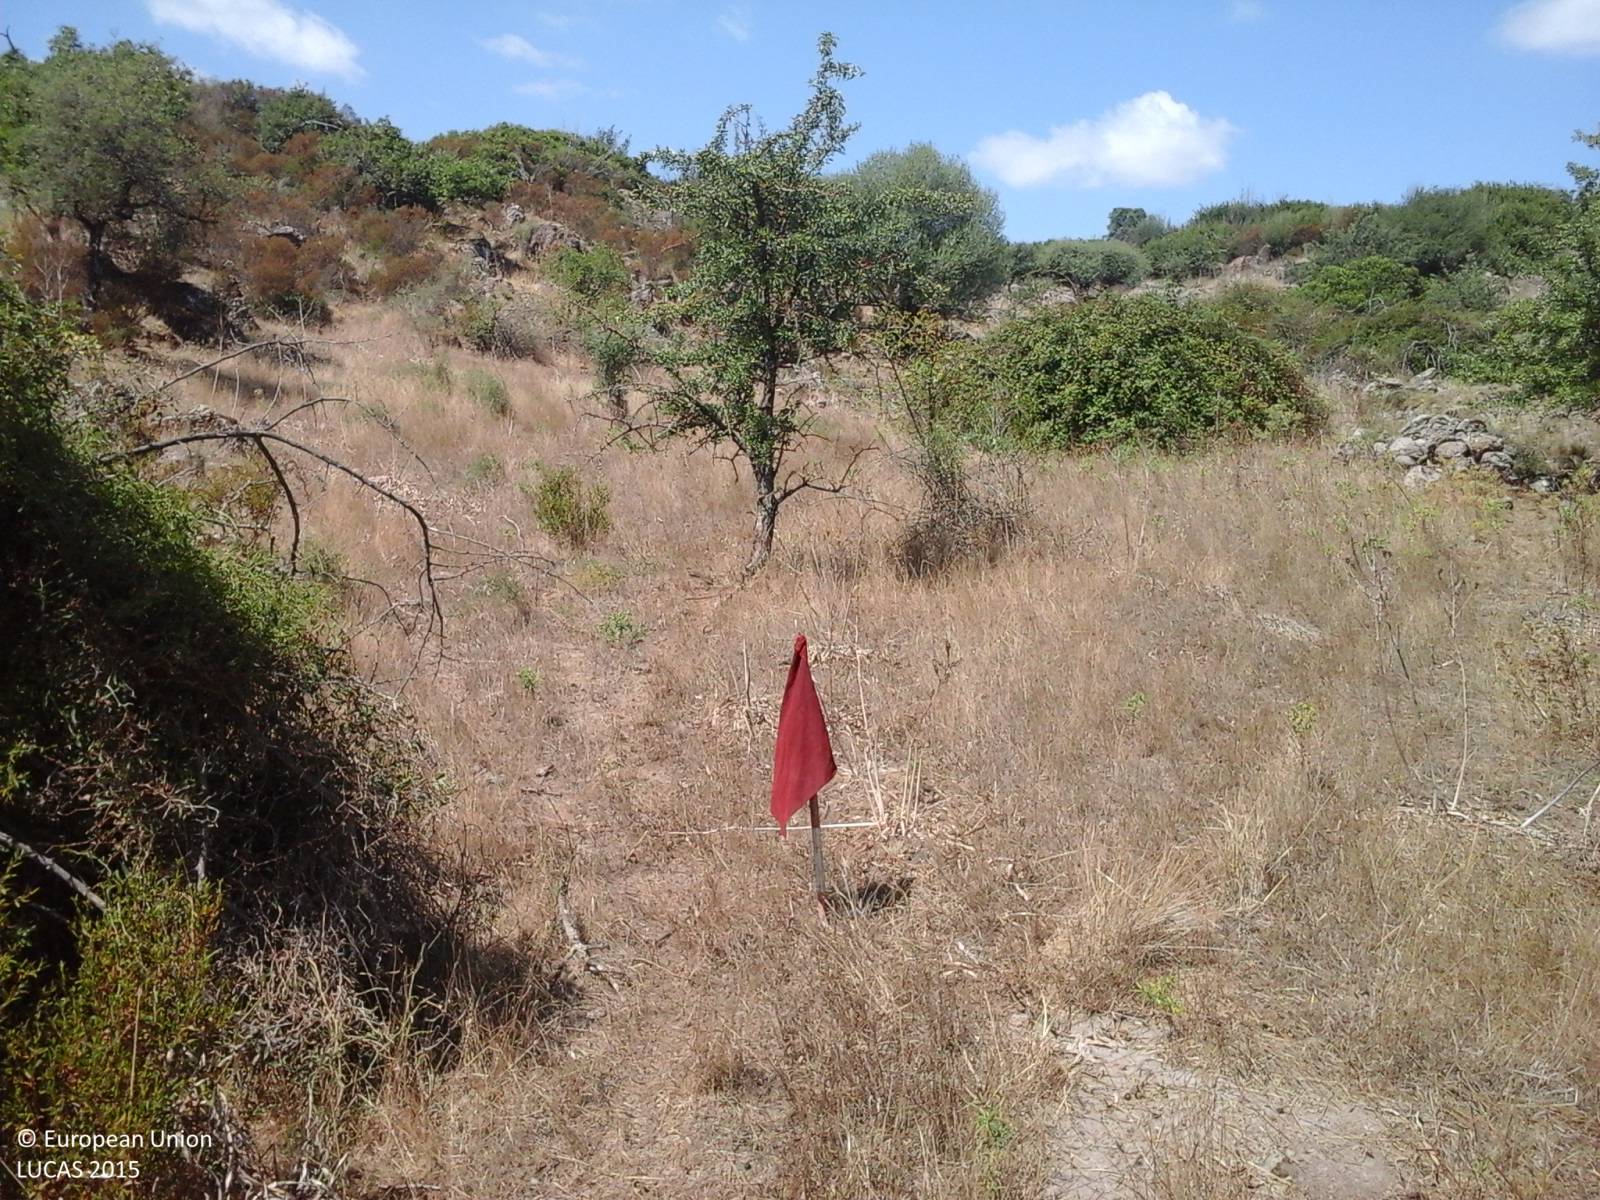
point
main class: Grassland
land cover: Grassland with sparse tree/shrub cover
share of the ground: 25 - 50 %
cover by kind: herbaceous plants 85 %, shrubs 10 %, broadleaved forest trees 5 %
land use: Agriculture (excluding fallow land and kitchen gardens)
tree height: < 5 m
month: July
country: IT
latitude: 40.5144
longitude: 8.8844
